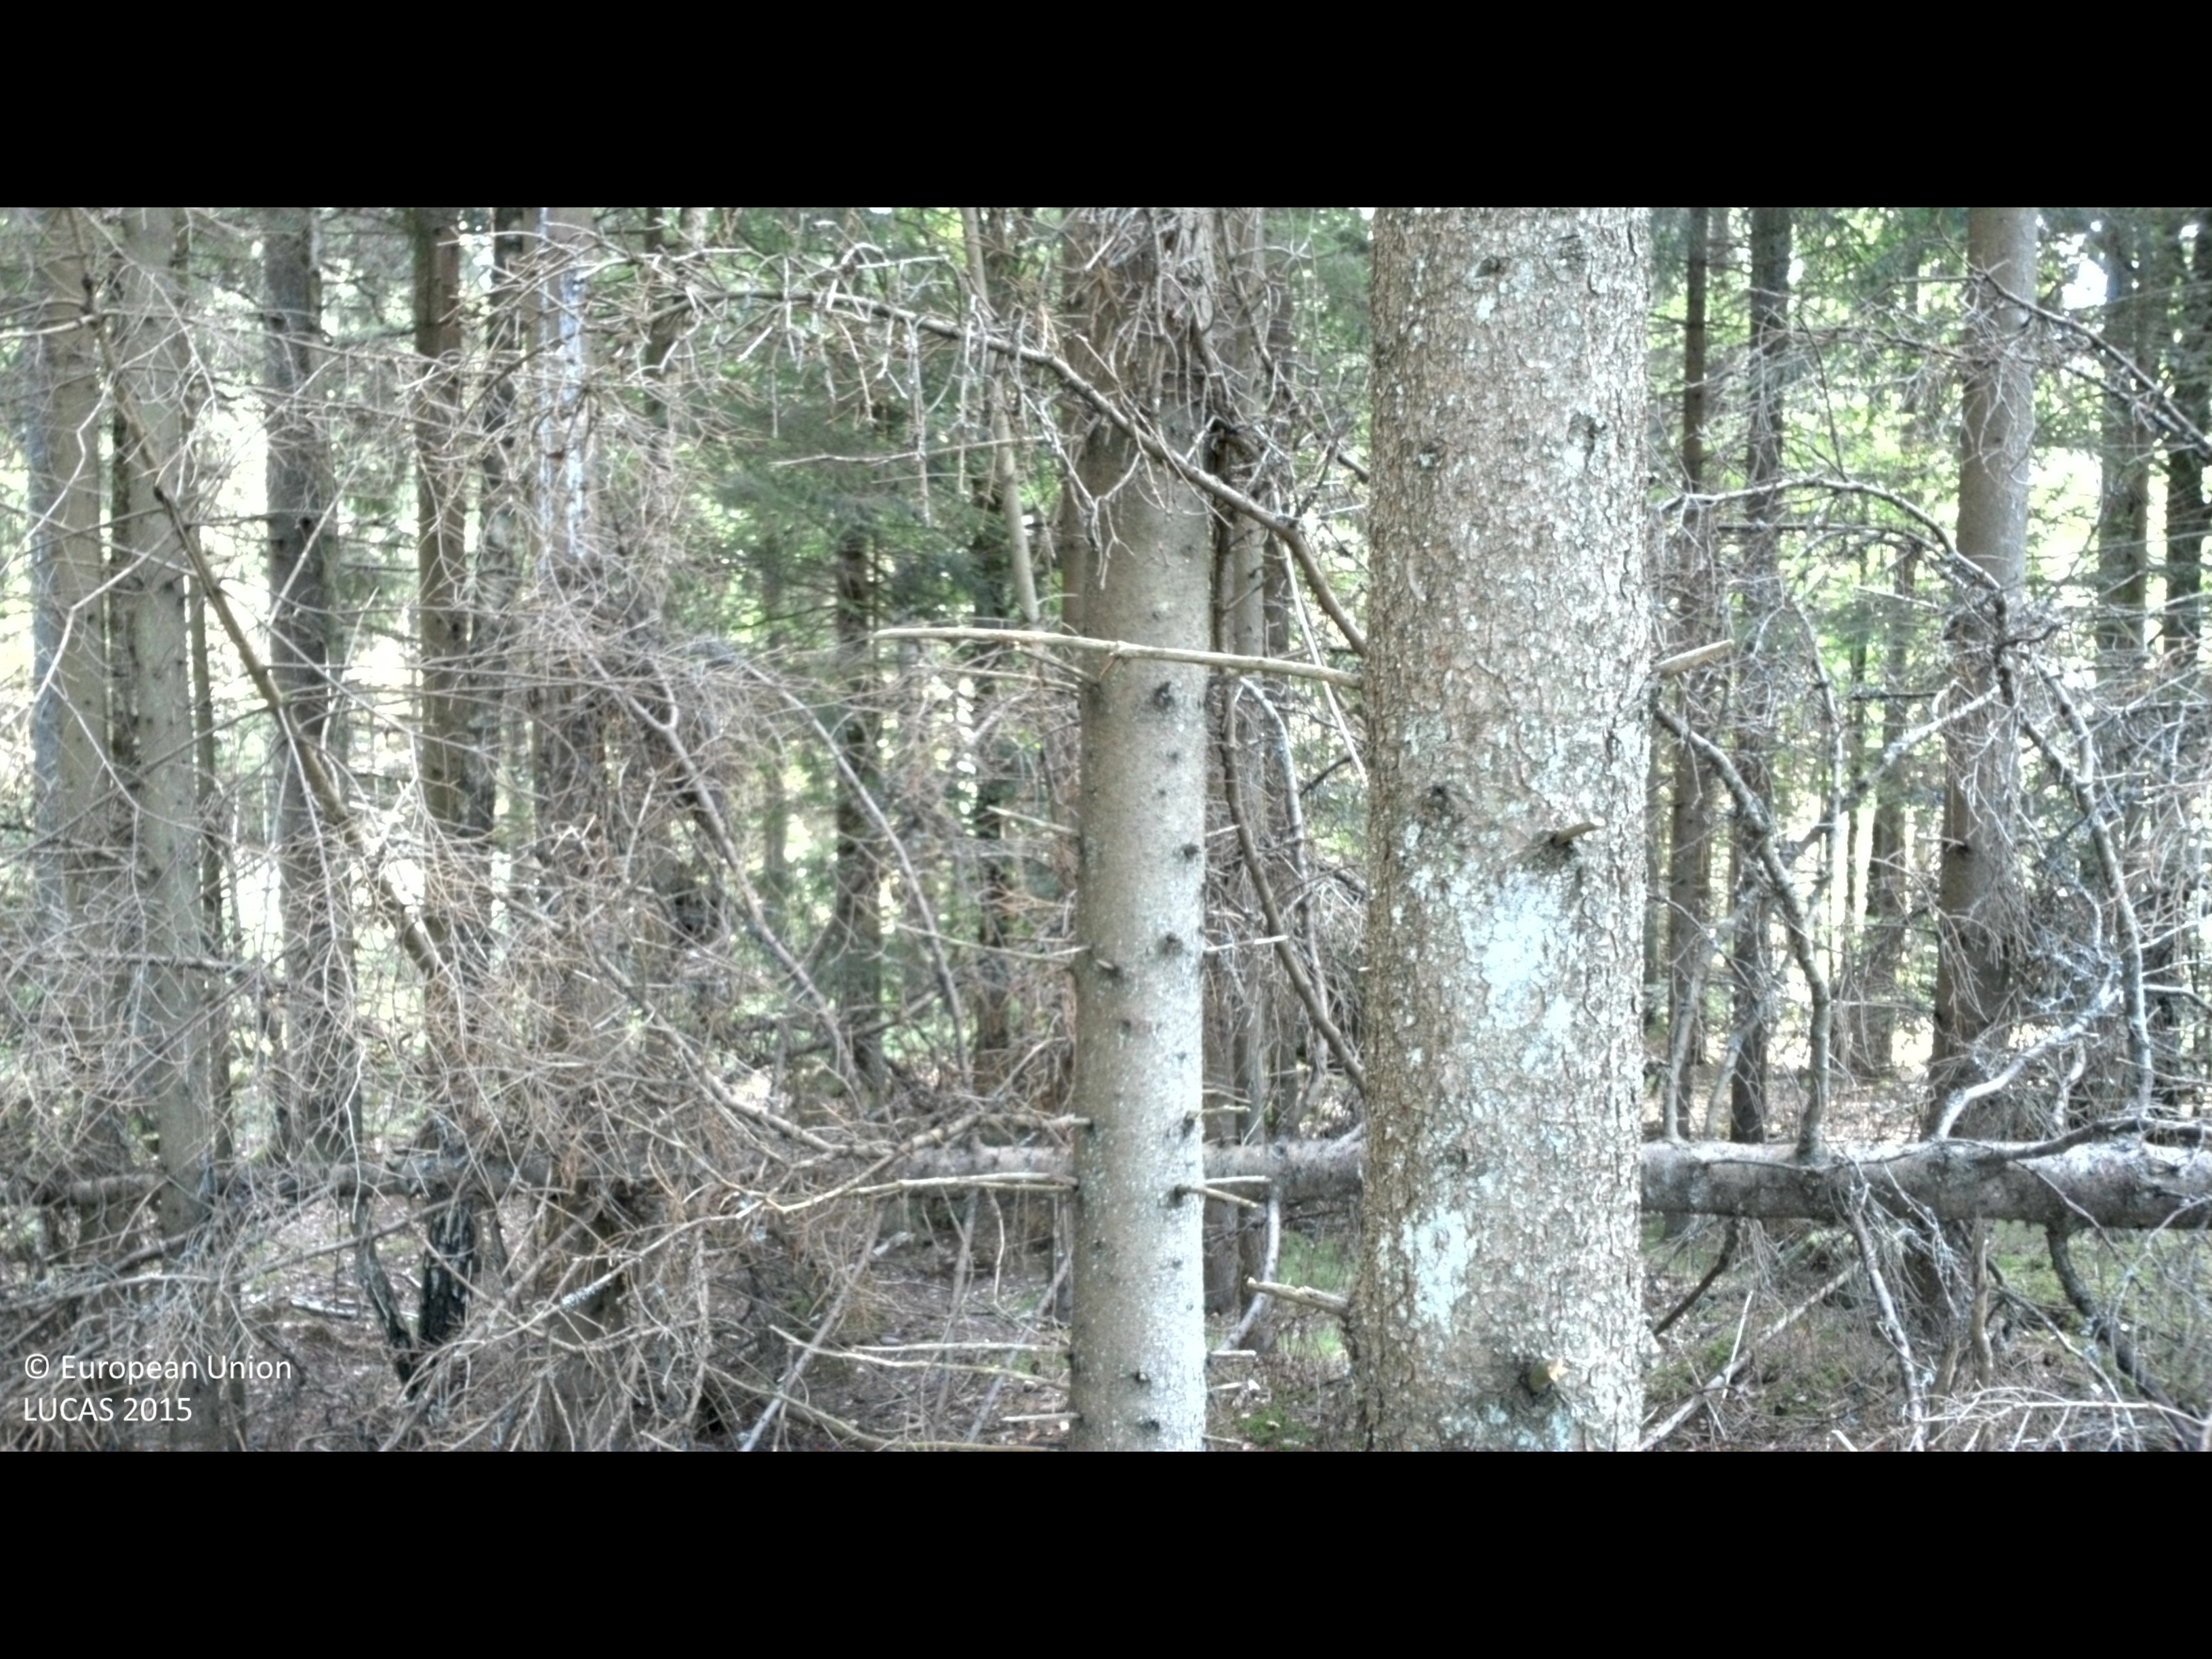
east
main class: Woodland
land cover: Spruce dominated coniferous woodland
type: boreal forest
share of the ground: 50 - 75 %
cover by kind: coniferous forest trees 70 %, lichens and mosses 25 %, herbaceous plants 5 %
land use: Forestry
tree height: > 5 m
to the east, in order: Spruce dominated coniferous woodland; Spruce dominated mixed woodland; Rivers and streams; Shrubland with sparse tree cover; Spruce dominated coniferous woodland
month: August
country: SE
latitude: 56.3704
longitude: 14.7417
